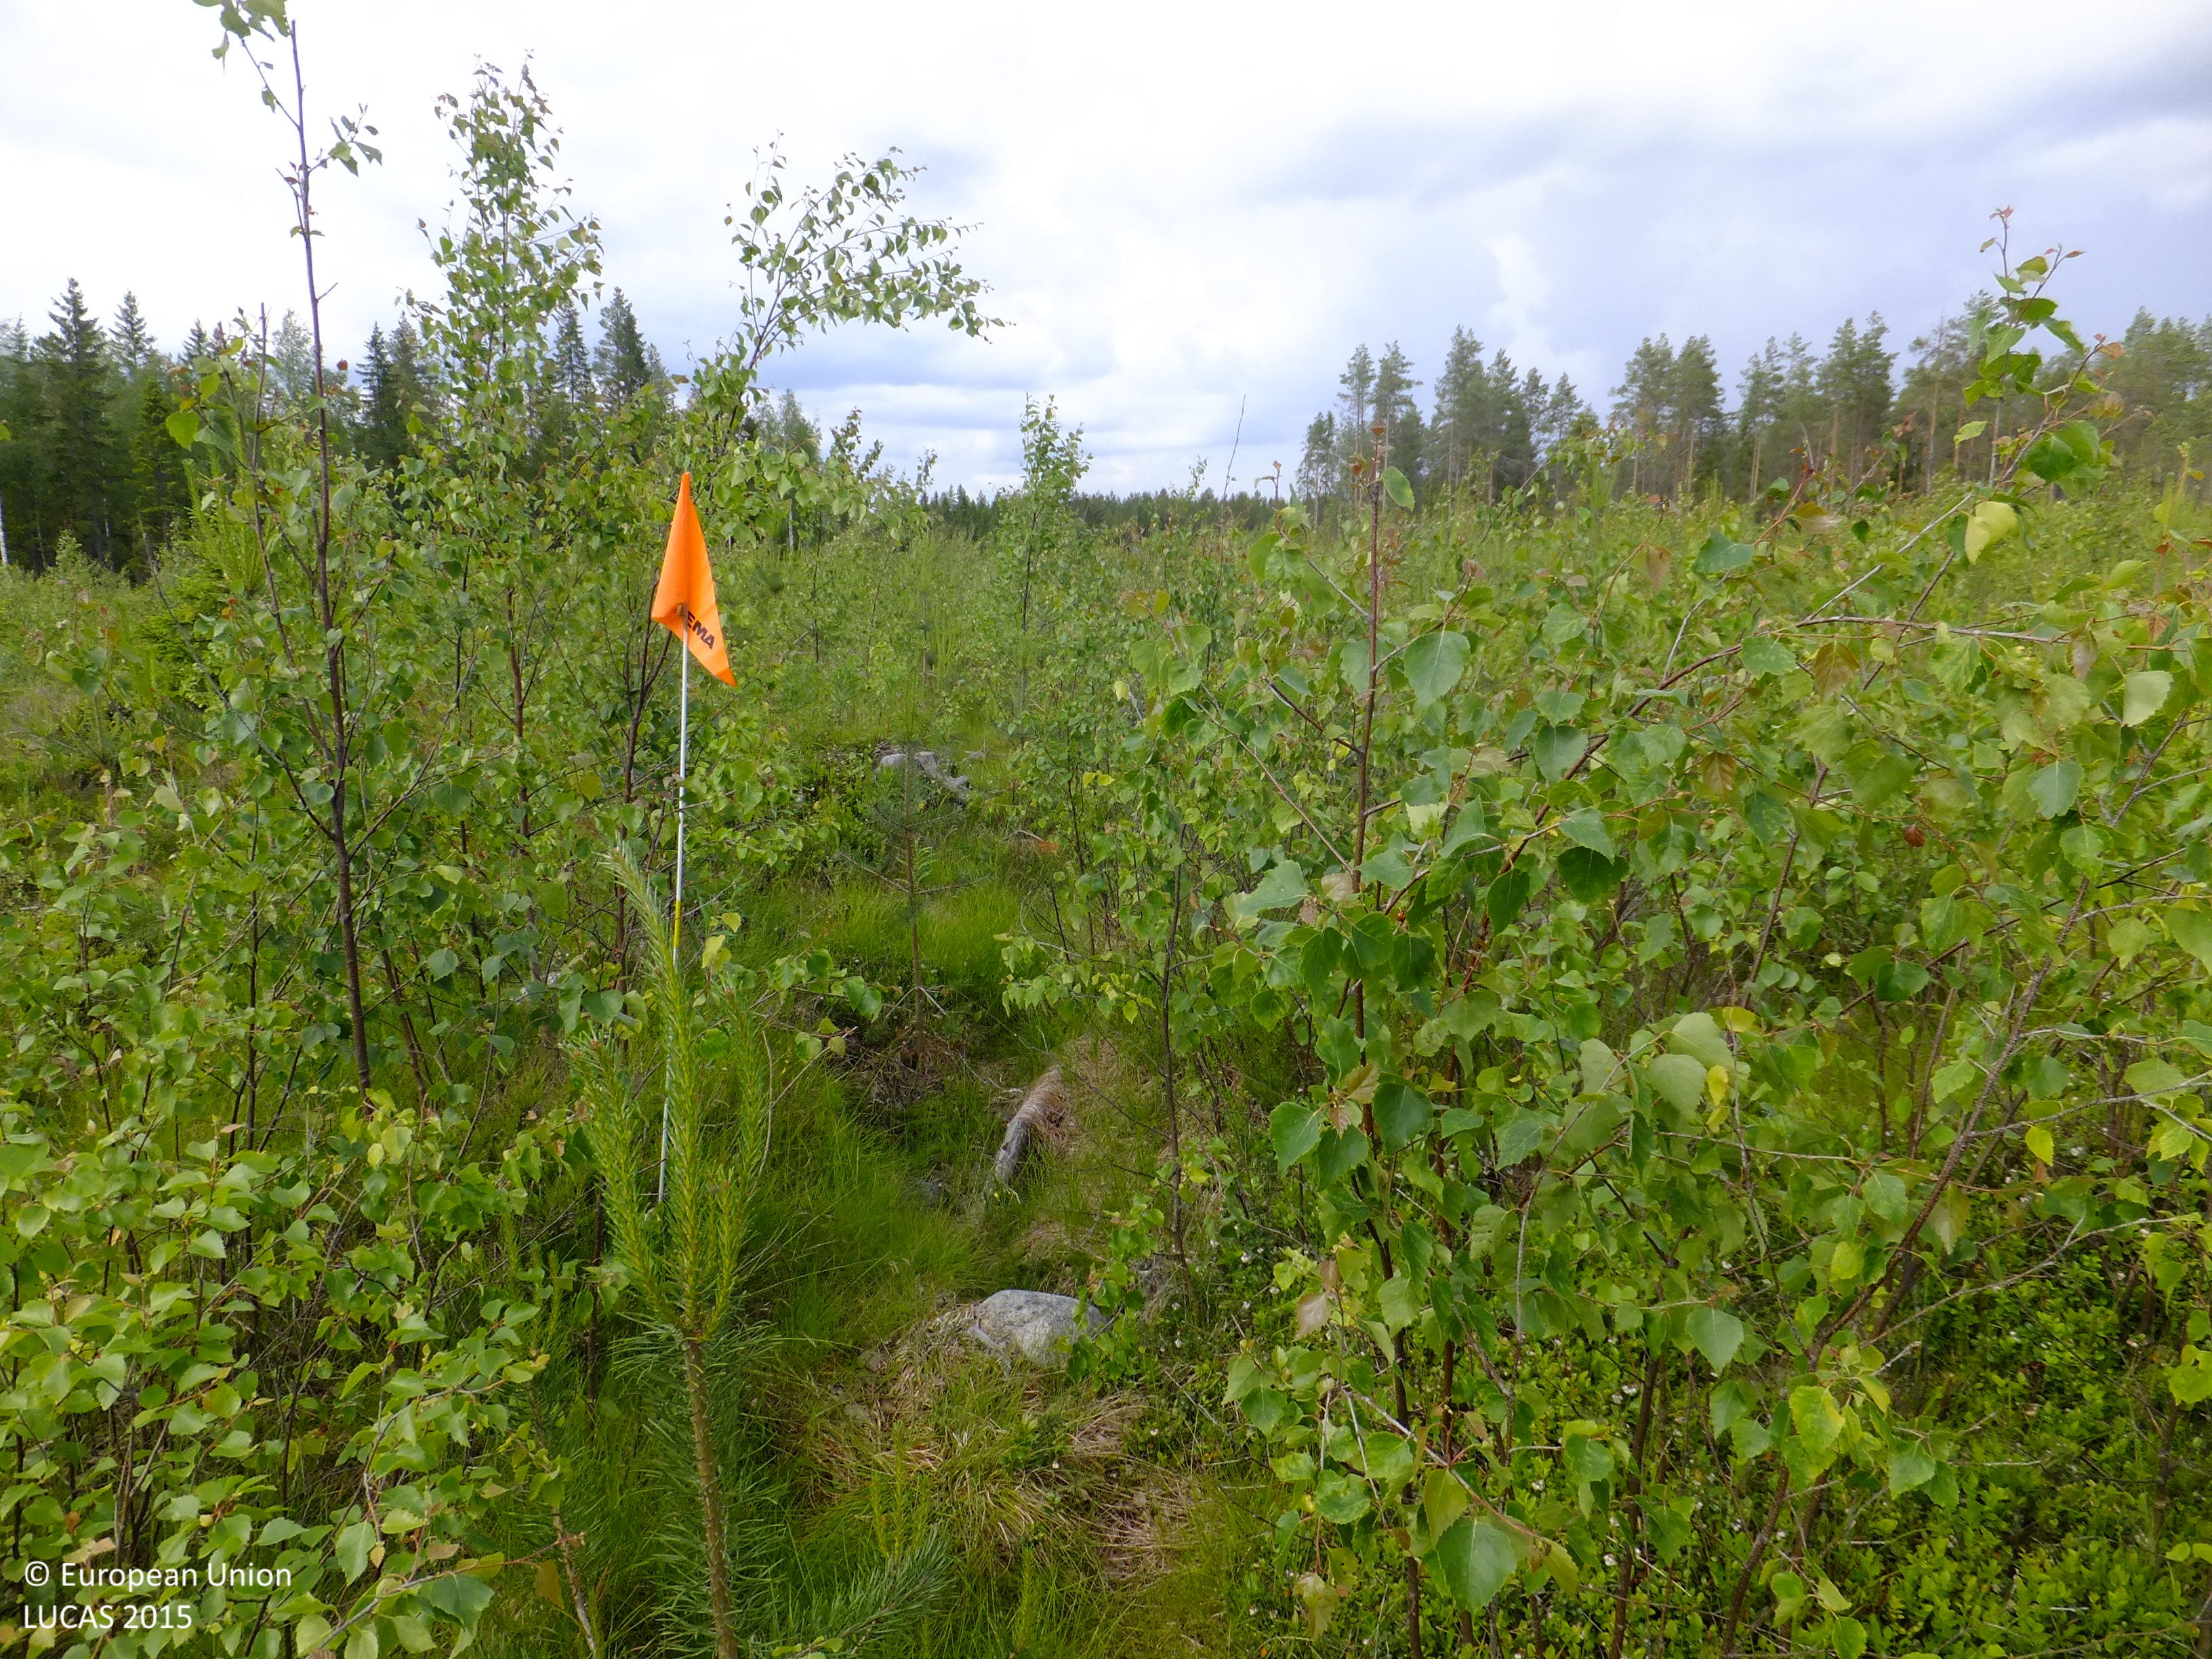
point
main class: Woodland
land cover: Pine dominated mixed woodland
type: boreal forest
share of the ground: 50 - 75 %
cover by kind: coniferous forest trees 30 %, broadleaved forest trees 30 %, herbaceous plants 20 %, shrubs 10 %, lichens and mosses 10 %
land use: Forestry
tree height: < 5 m
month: June
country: FI
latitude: 63.2448
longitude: 23.9497
